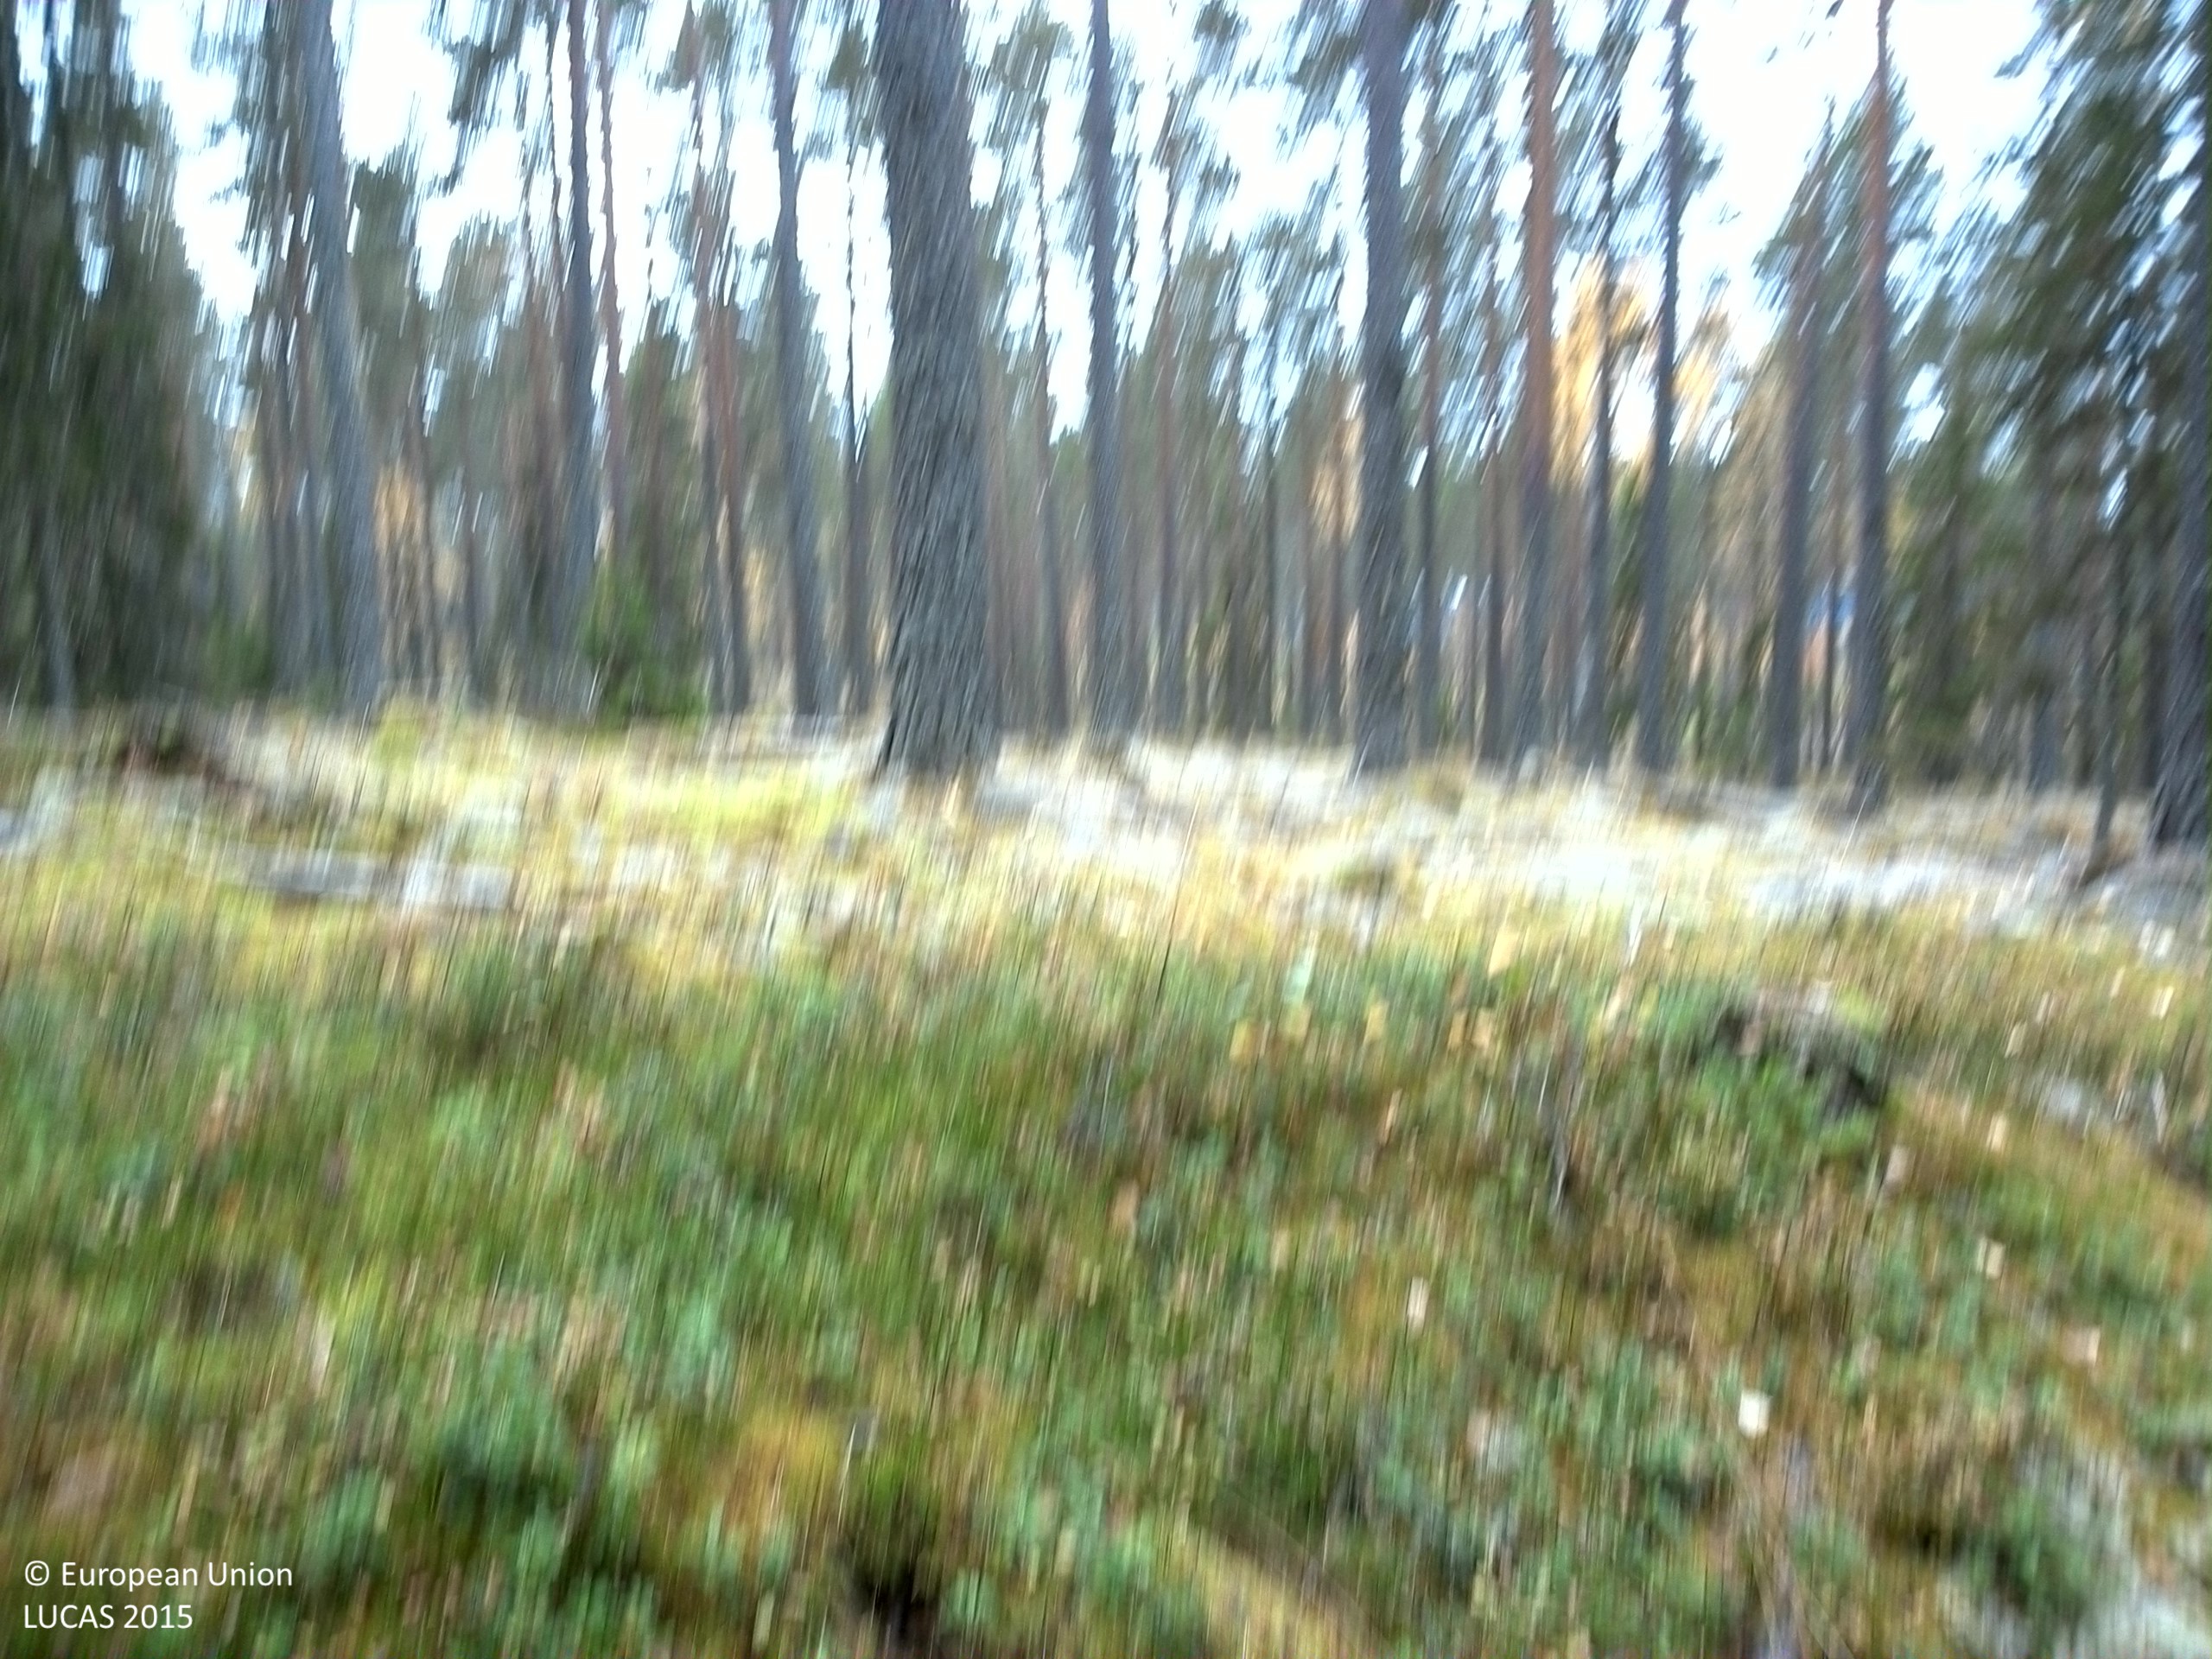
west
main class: Woodland
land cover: Pine dominated coniferous woodland
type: boreal forest
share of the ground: 50 - 75 %
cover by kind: coniferous forest trees 55 %, shrubs 25 %, lichens and mosses 20 %
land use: Forestry
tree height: > 5 m
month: October
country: SE
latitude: 61.2326
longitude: 14.3263
